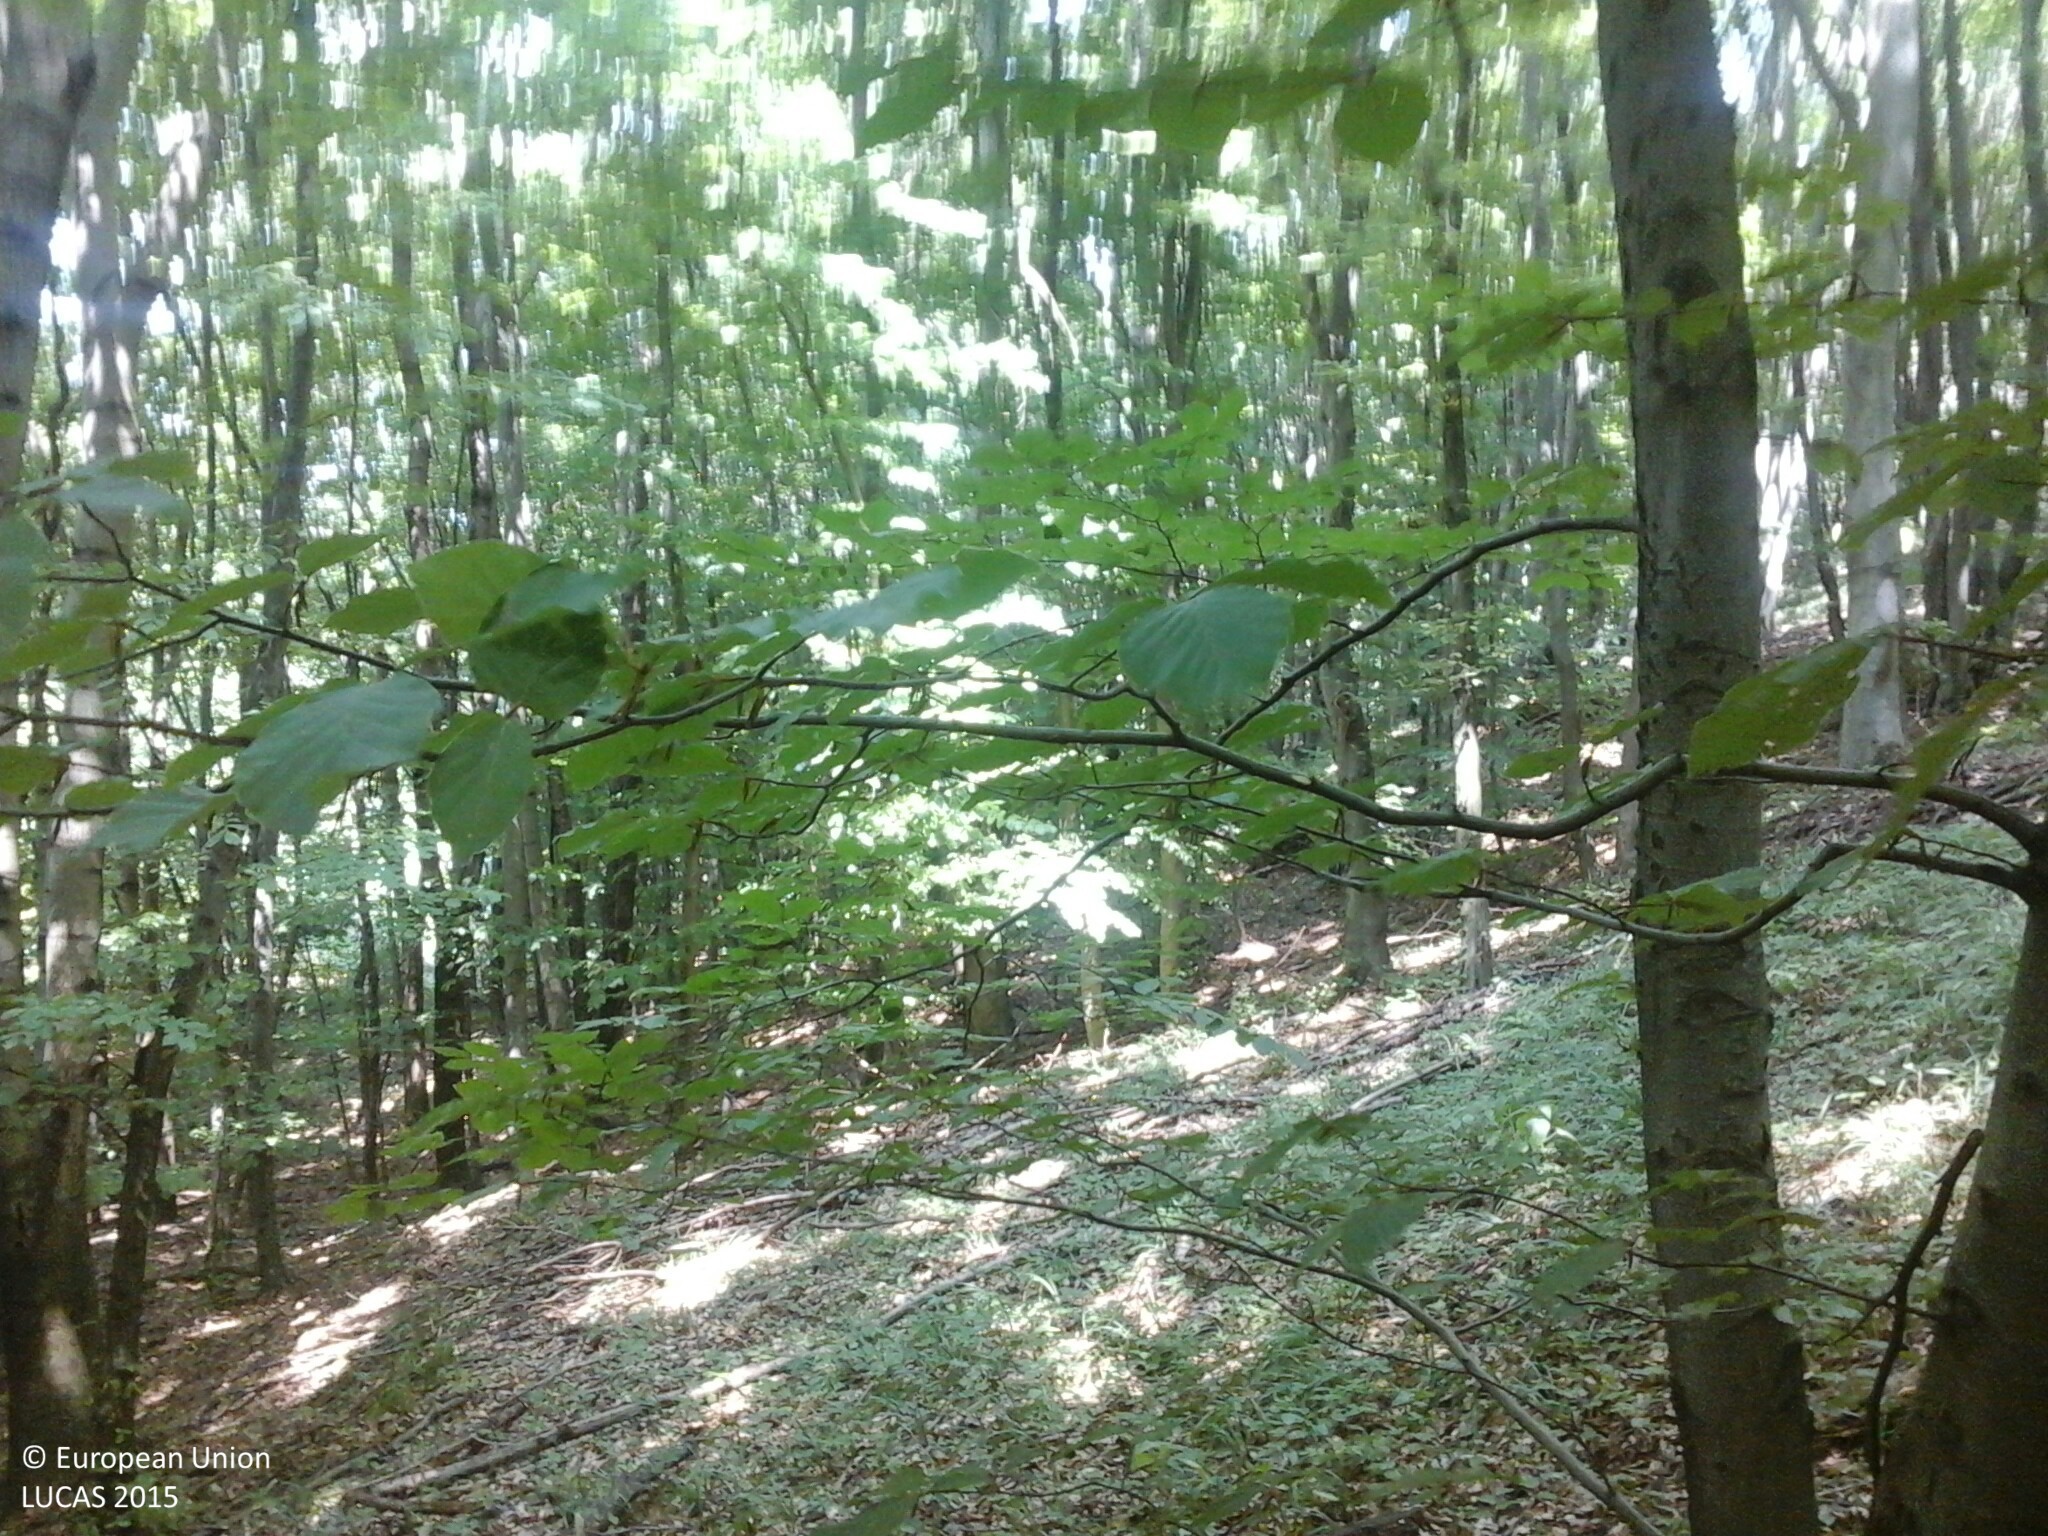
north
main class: Woodland
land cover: Broadleaved woodland
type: beech forest
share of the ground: > 75 %
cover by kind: broadleaved forest trees 100 %
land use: Forestry
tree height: > 5 m
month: August
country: HU
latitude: 47.4041
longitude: 18.2942
